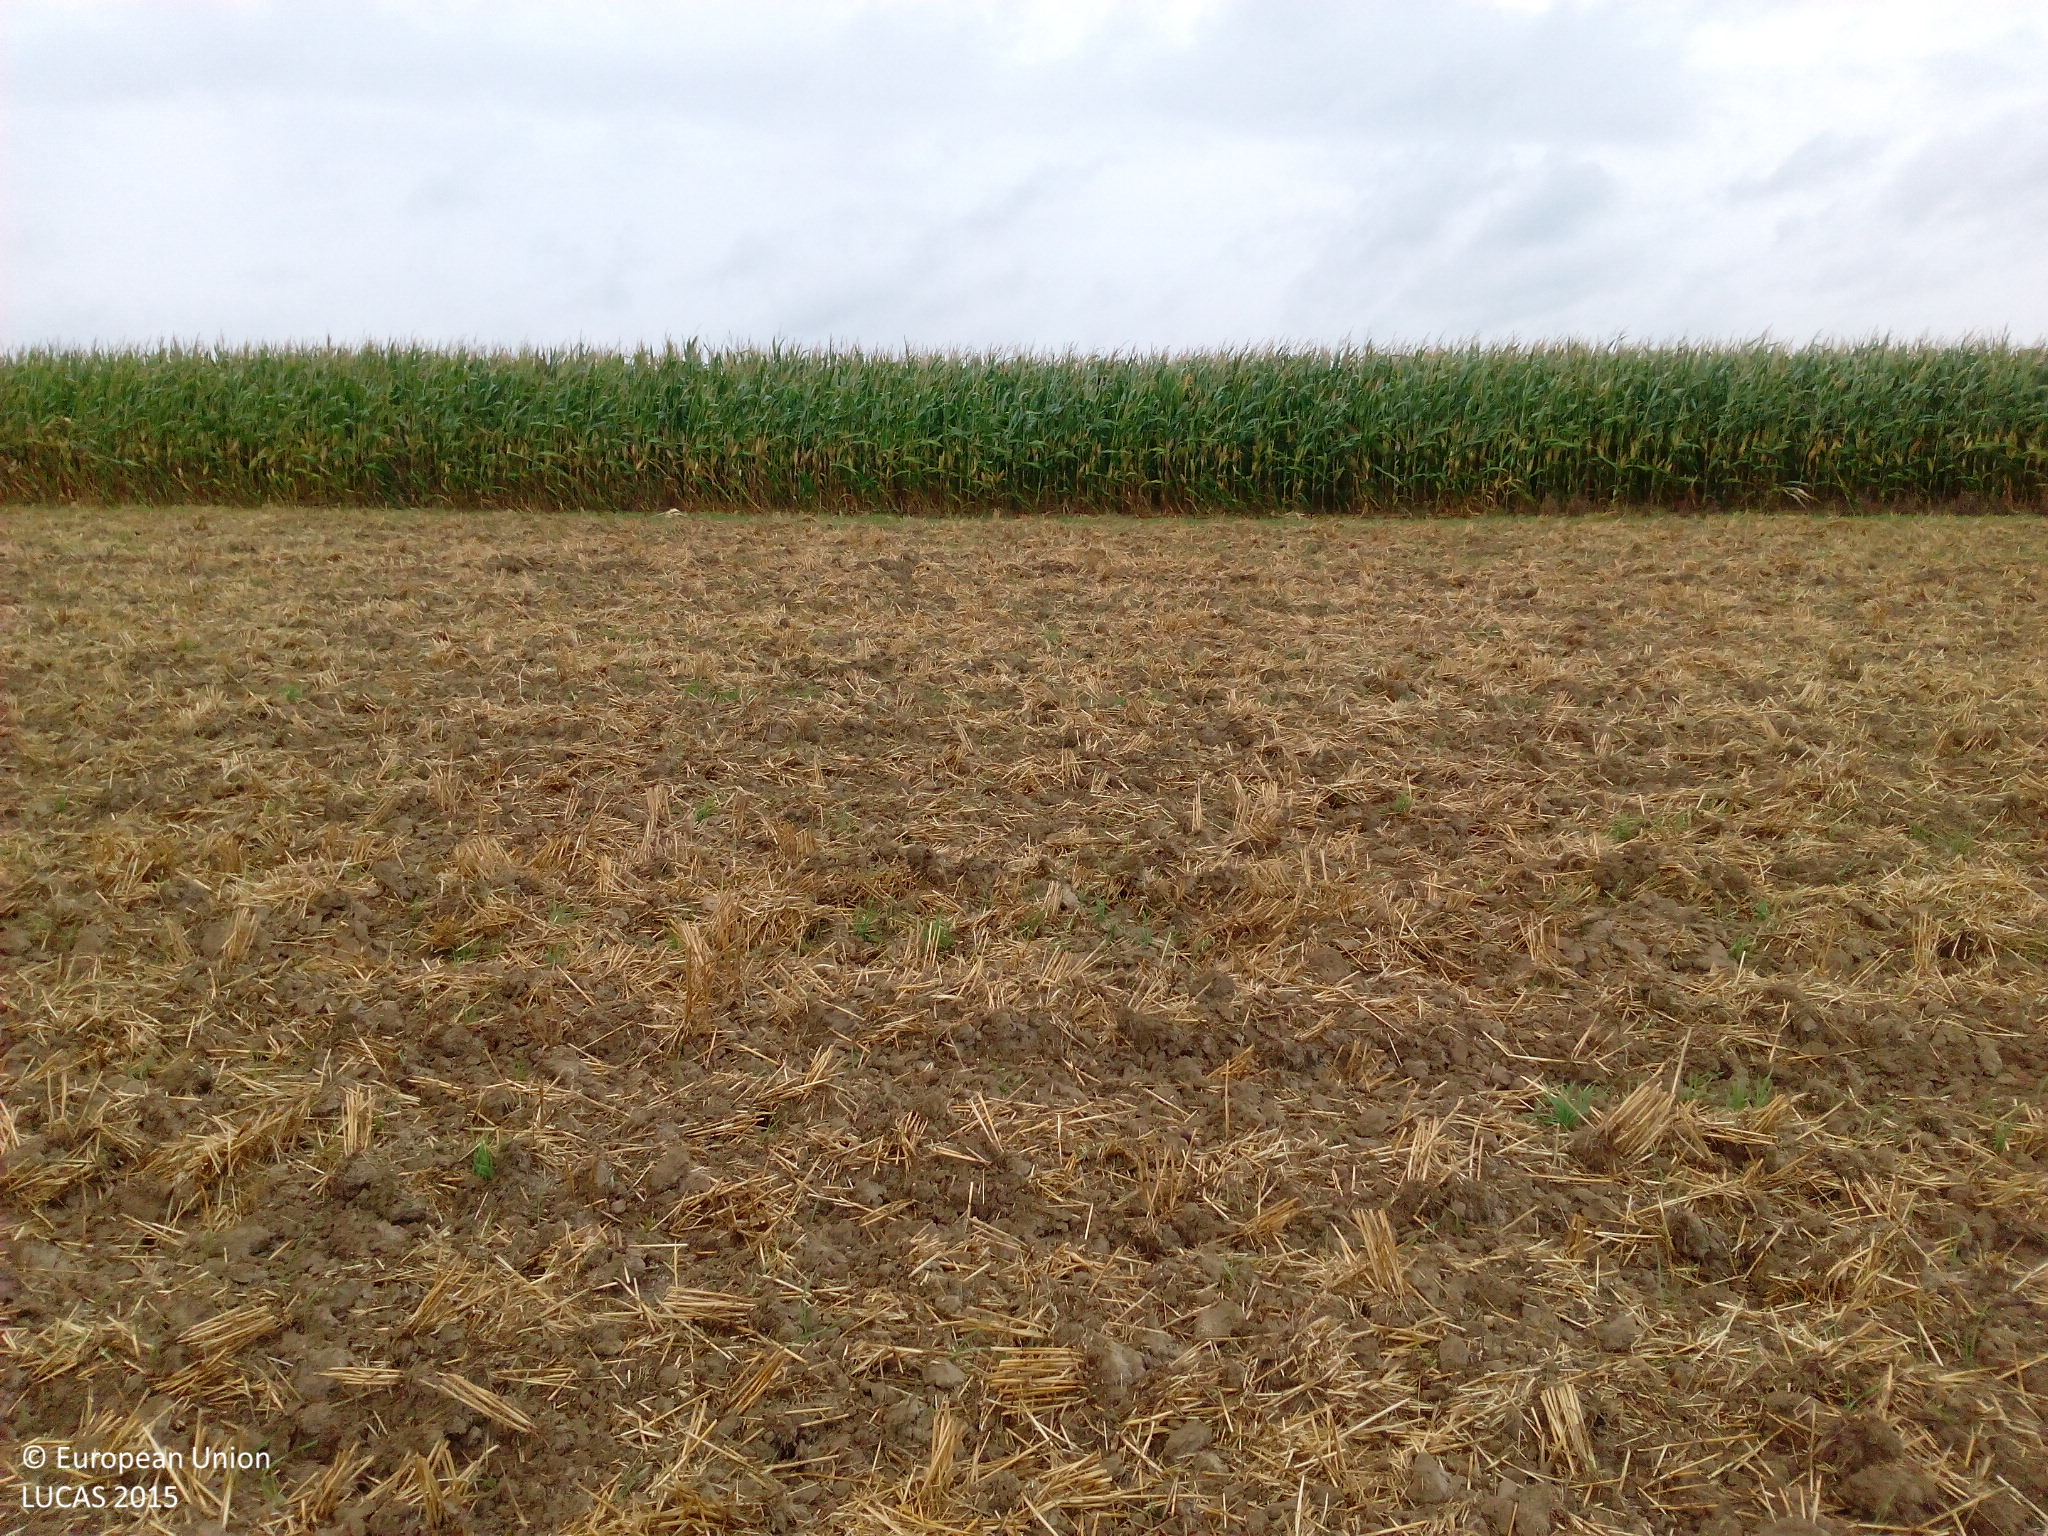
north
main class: Cropland
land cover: Common wheat
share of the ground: < 10 %
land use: Agriculture (excluding fallow land and kitchen gardens)
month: September
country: DE
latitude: 48.2952
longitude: 10.2560
